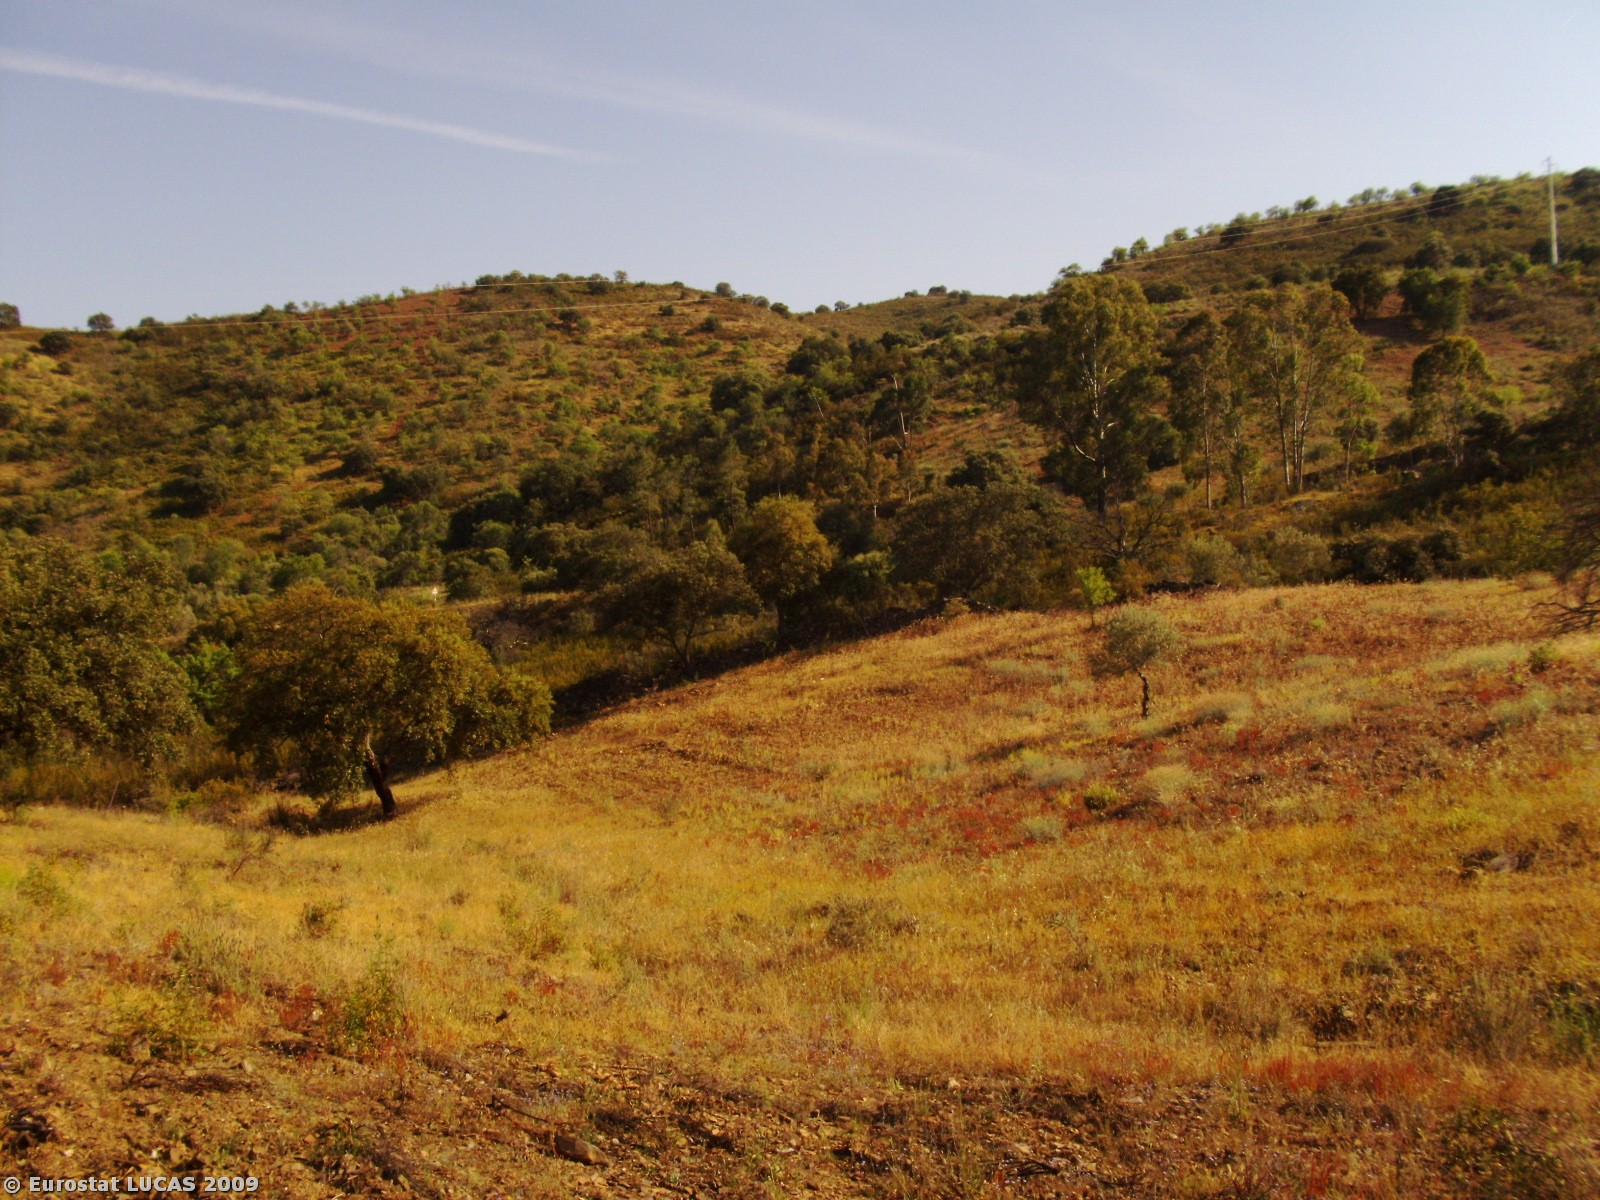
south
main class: Grassland
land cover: Grassland with sparse tree/shrub cover
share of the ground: 25 - 50 %
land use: Forestry
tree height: > 5 m
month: May
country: PT
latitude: 37.3827
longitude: -7.5242
